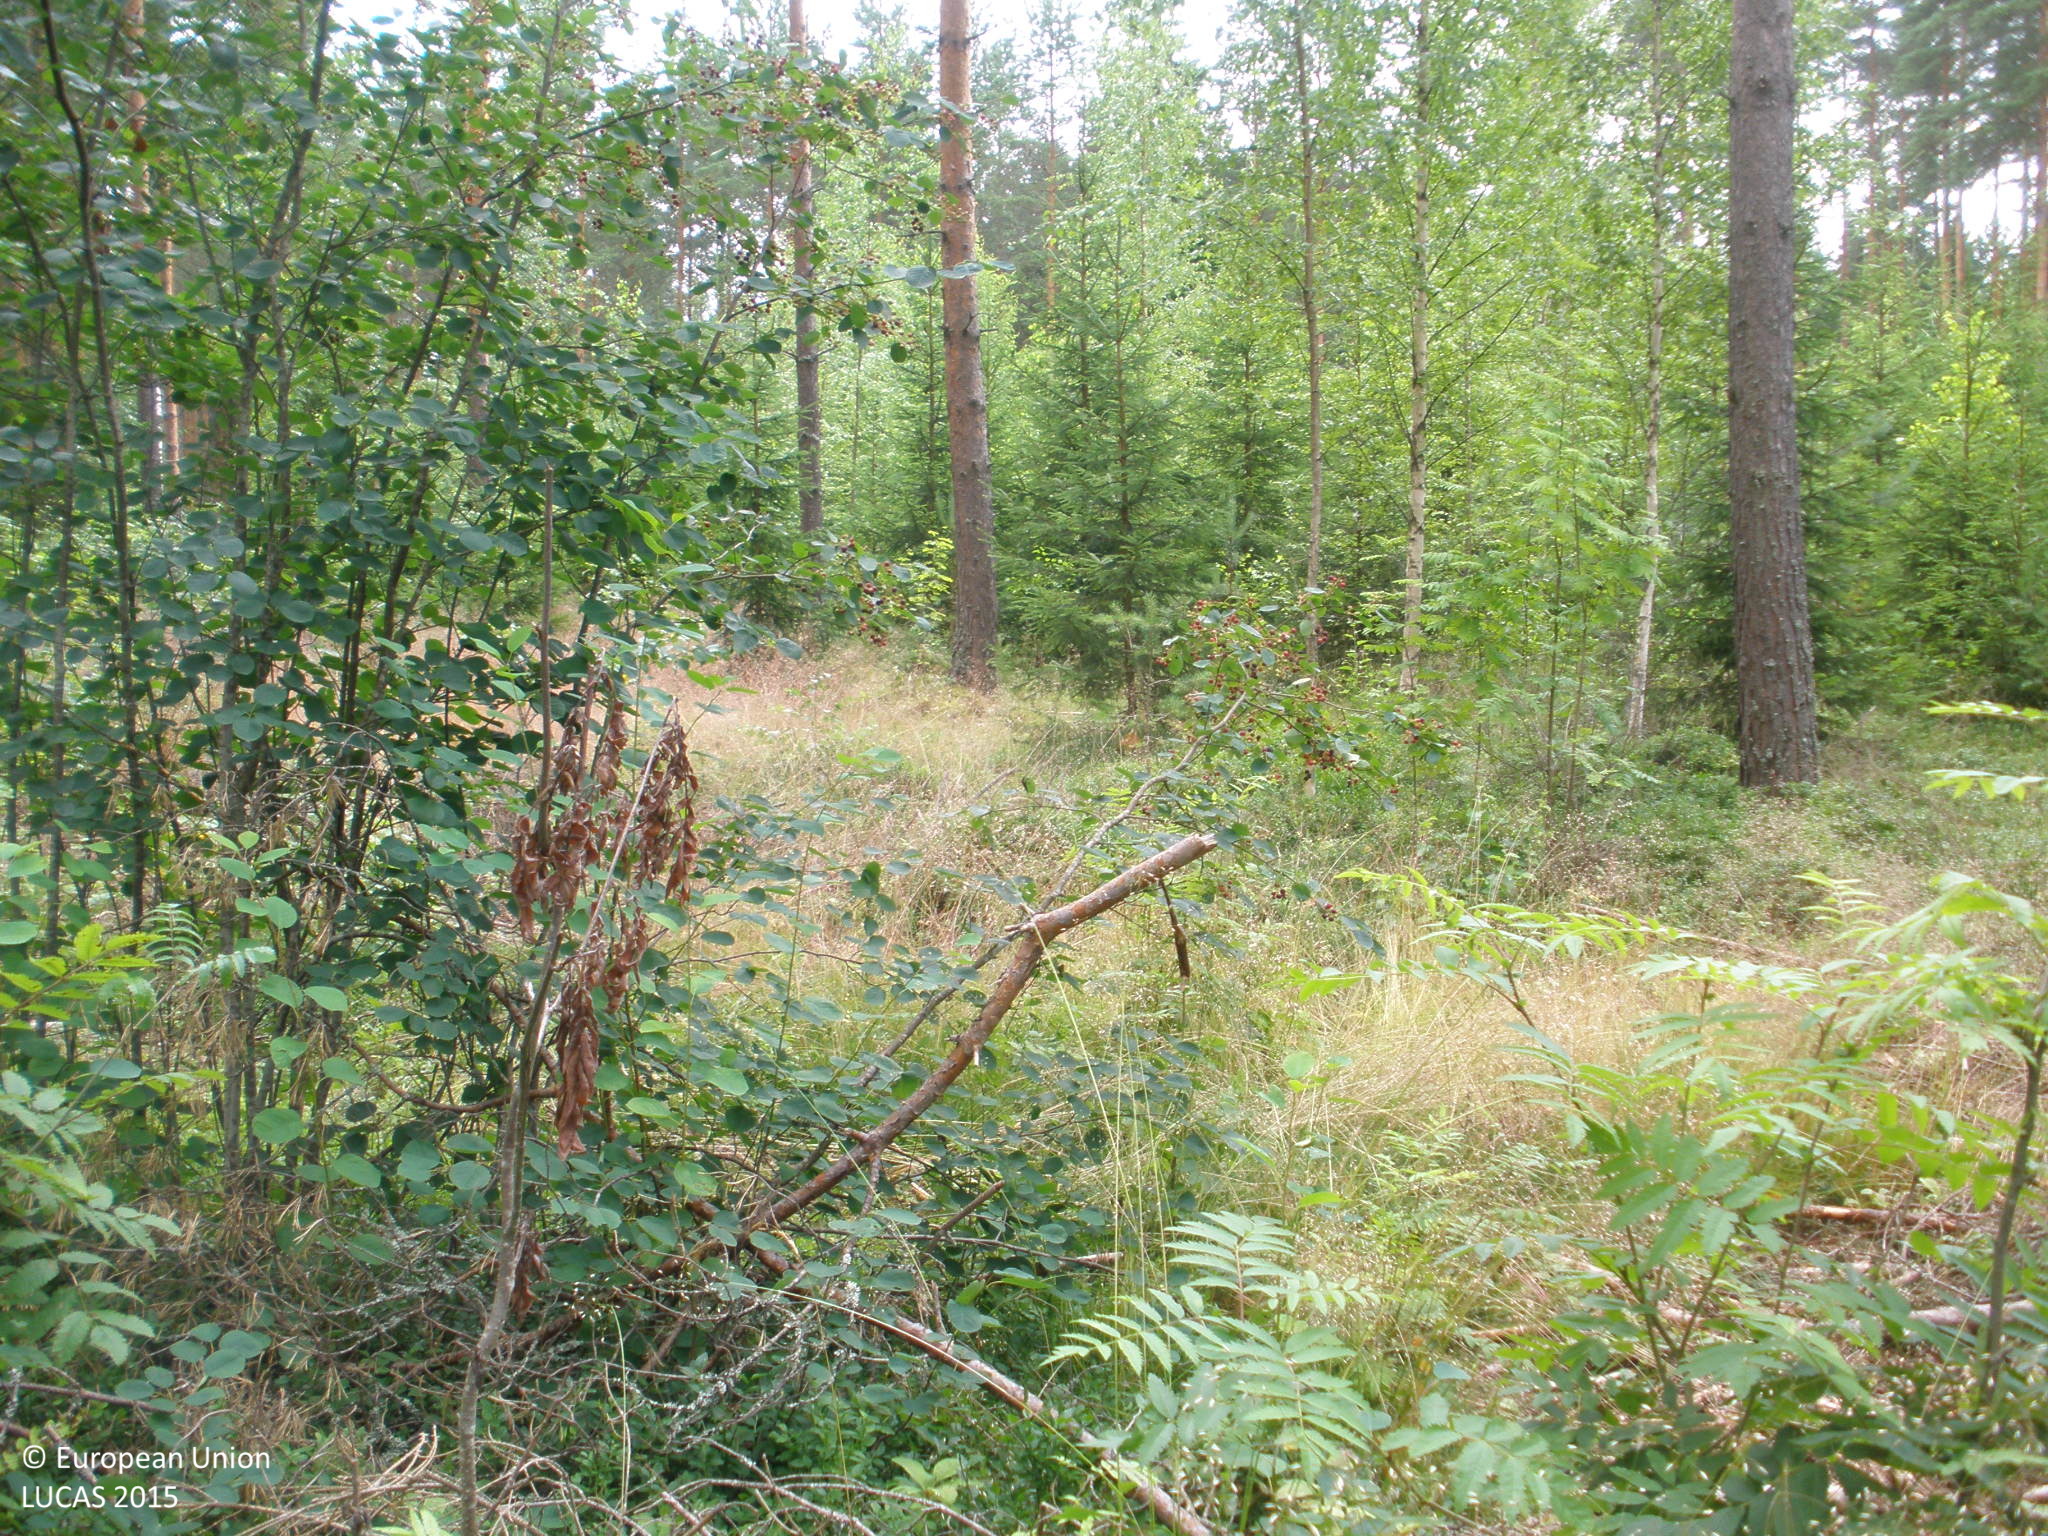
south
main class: Woodland
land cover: Pine dominated mixed woodland
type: boreal forest
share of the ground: 50 - 75 %
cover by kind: coniferous forest trees 50 %, broadleaved forest trees 20 %, herbaceous plants 15 %, shrubs 10 %, lichens and mosses 5 %
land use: Forestry
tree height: > 5 m
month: August
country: FI
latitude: 60.9048
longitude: 24.5770
